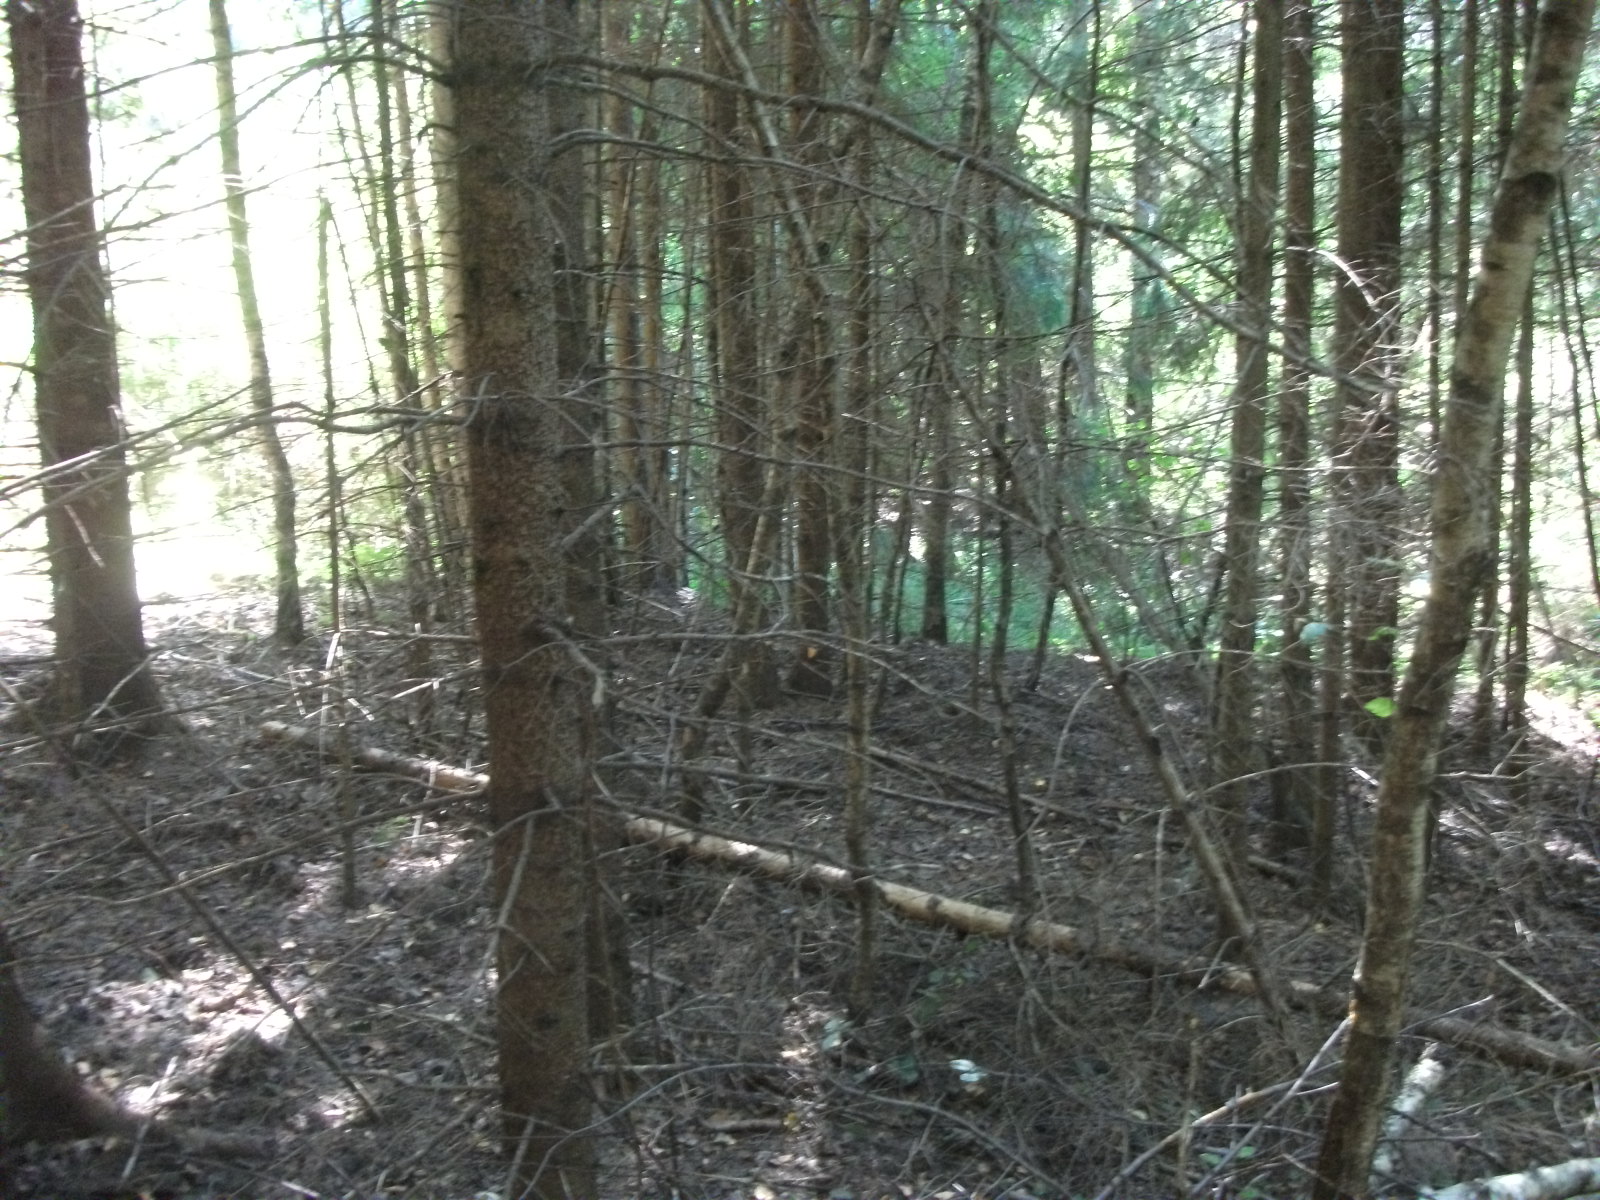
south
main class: Woodland
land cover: Spruce dominated coniferous woodland
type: hemiboreal forest and nemoral coniferous forest and mixed broadleaved-coniferous forest
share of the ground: > 75 %
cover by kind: coniferous forest trees 80 %, unconsolidated bare surface 10 %, broadleaved forest trees 5 %, herbaceous plants 5 %
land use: Forestry
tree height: > 5 m
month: August
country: LV
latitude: 56.5102
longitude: 26.0432
